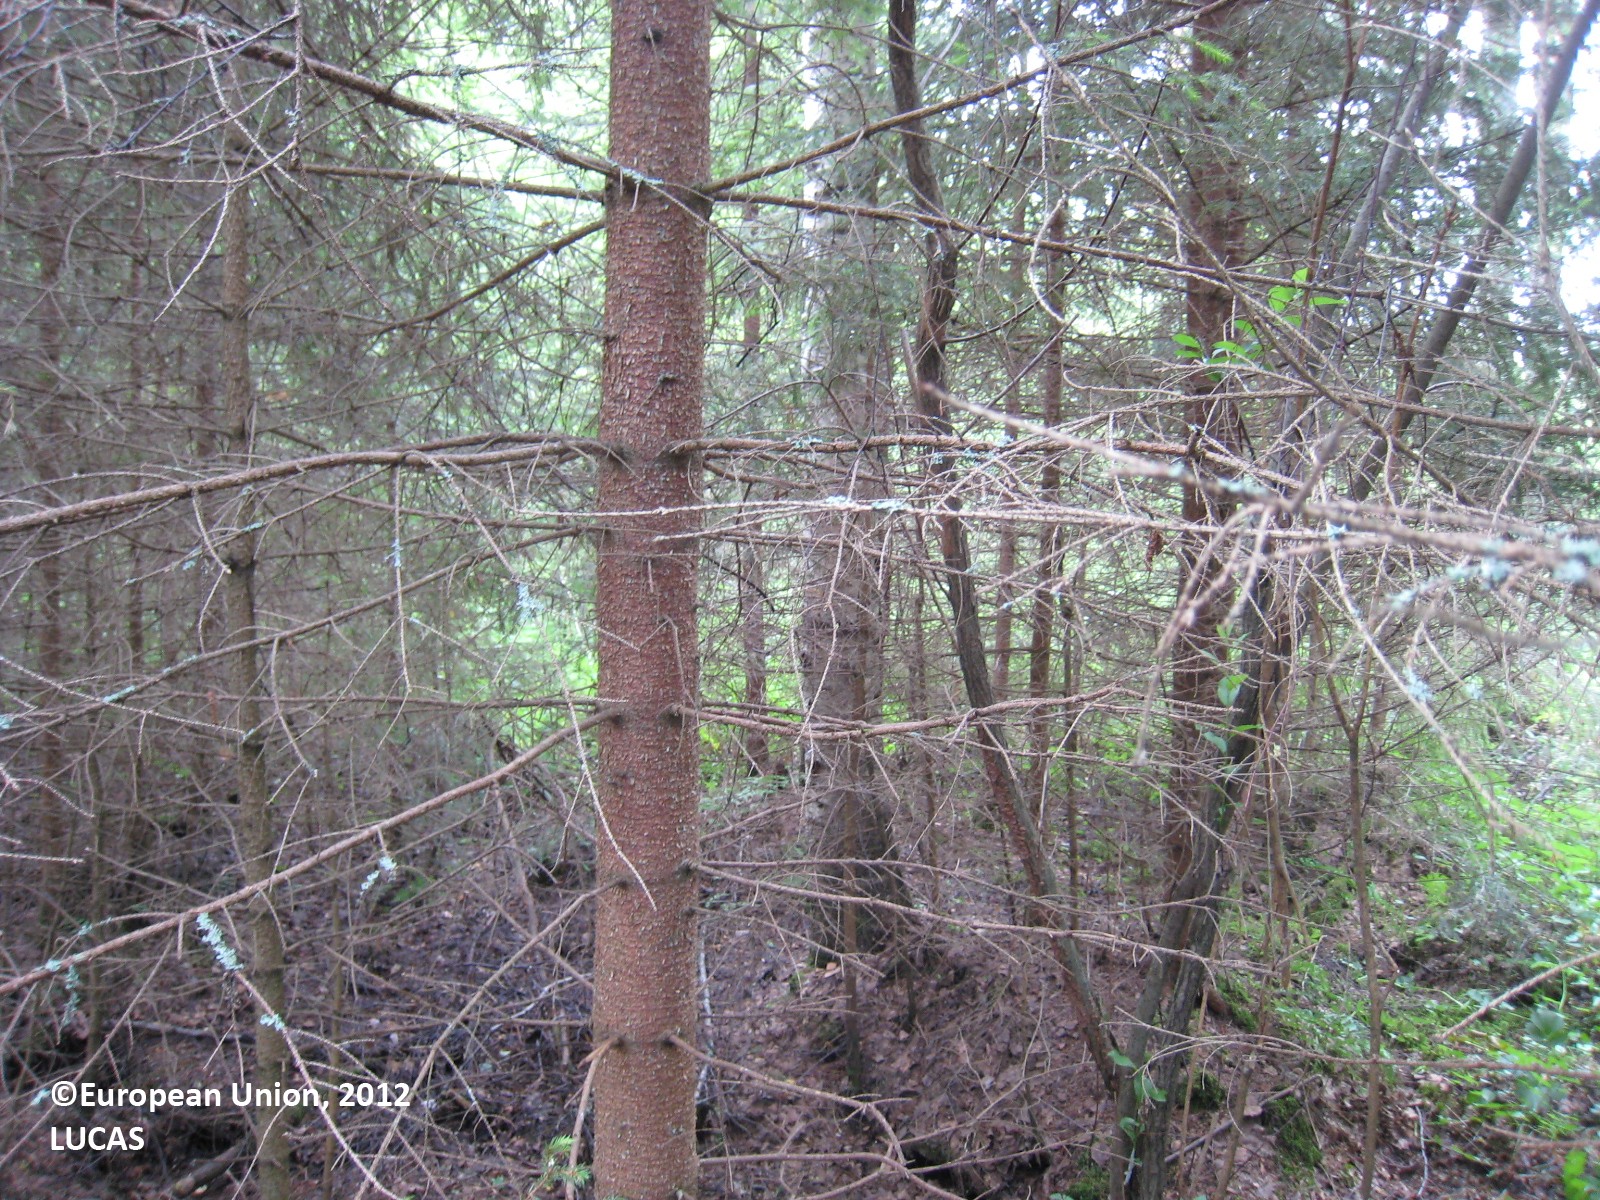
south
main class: Woodland
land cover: Spruce dominated mixed woodland
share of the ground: > 75 %
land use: Forestry
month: July
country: FI
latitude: 61.8981
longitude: 27.1177
